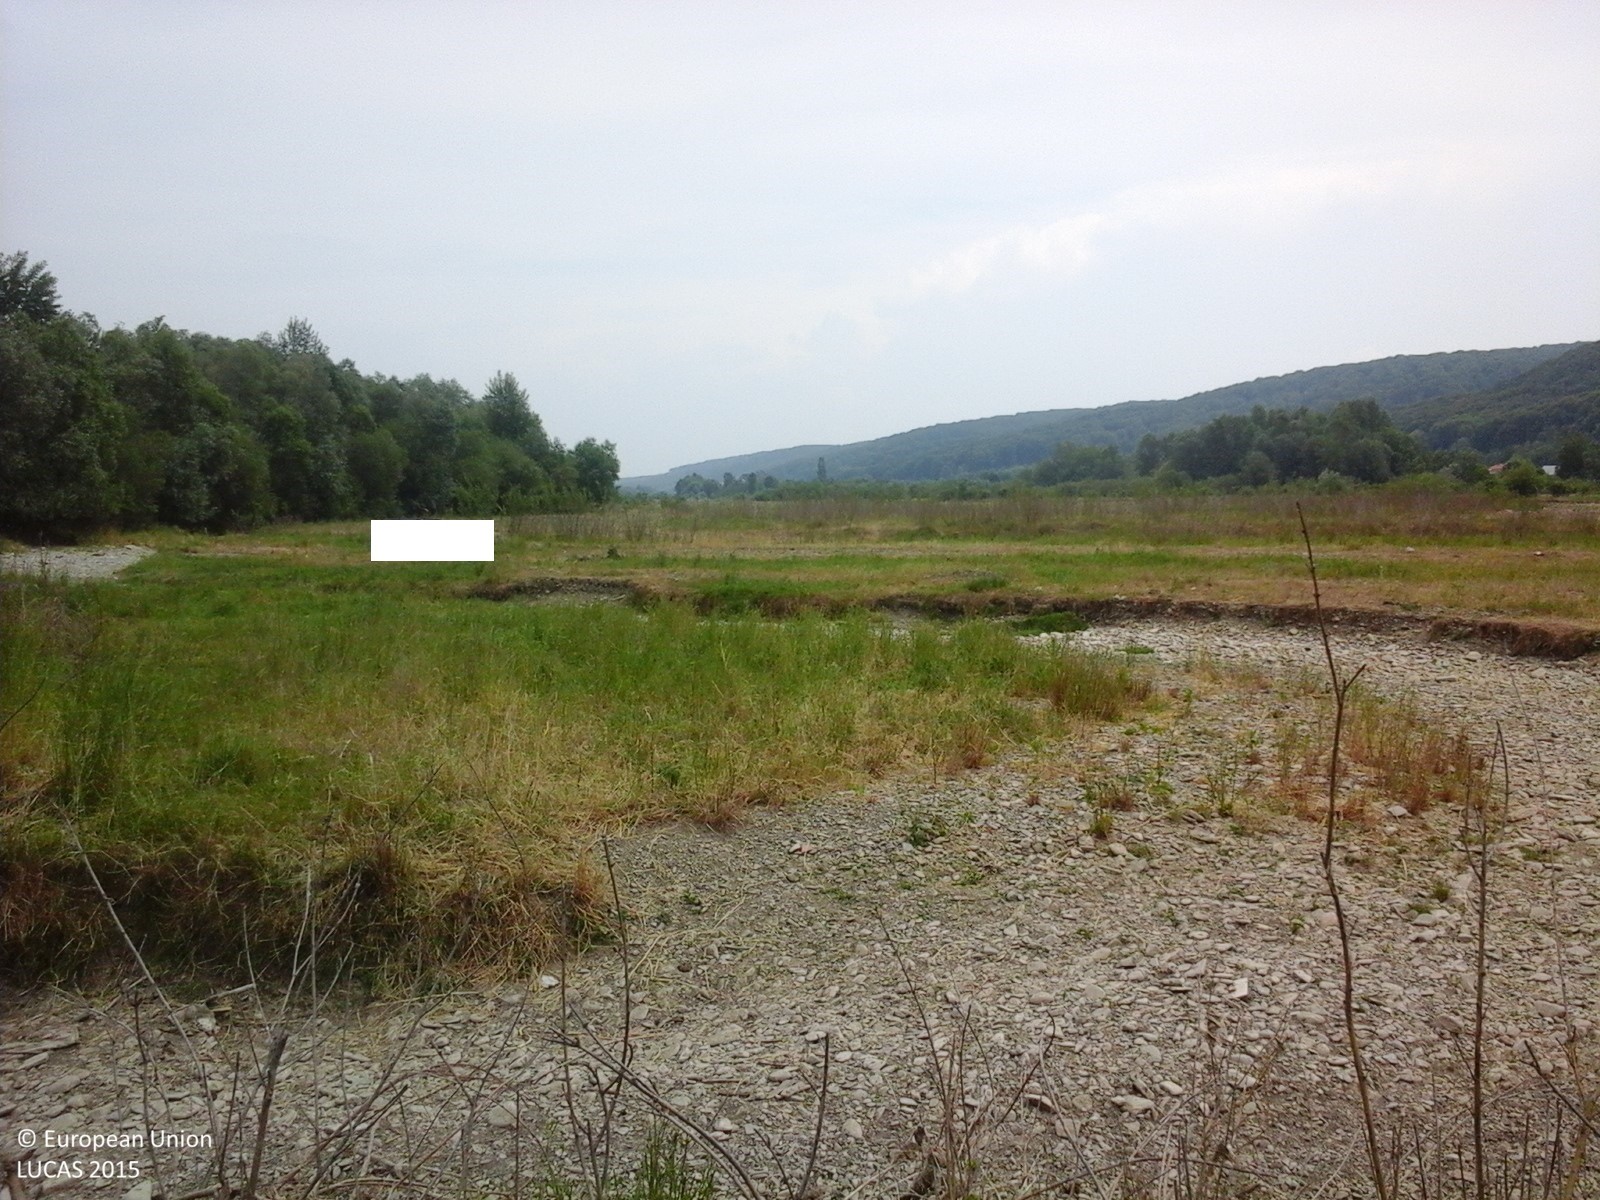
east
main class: Artificial land
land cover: Non built-up linear features
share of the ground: > 75 %
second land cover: Spontaneously vegetated surfaces
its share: > 75 %
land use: Electricity, gas and thermal power distribution
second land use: Agriculture (excluding fallow land and kitchen gardens)
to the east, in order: Electric lines; Spontaneously vegetated surfaces; Inland fresh running water; Grassland without tree/shrub cover; Inland fresh running water; Grassland without tree/shrub cover; Tracks; Grassland without tree/shrub cover; Inland fresh running water
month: June
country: RO
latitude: 47.2023
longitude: 26.4142
